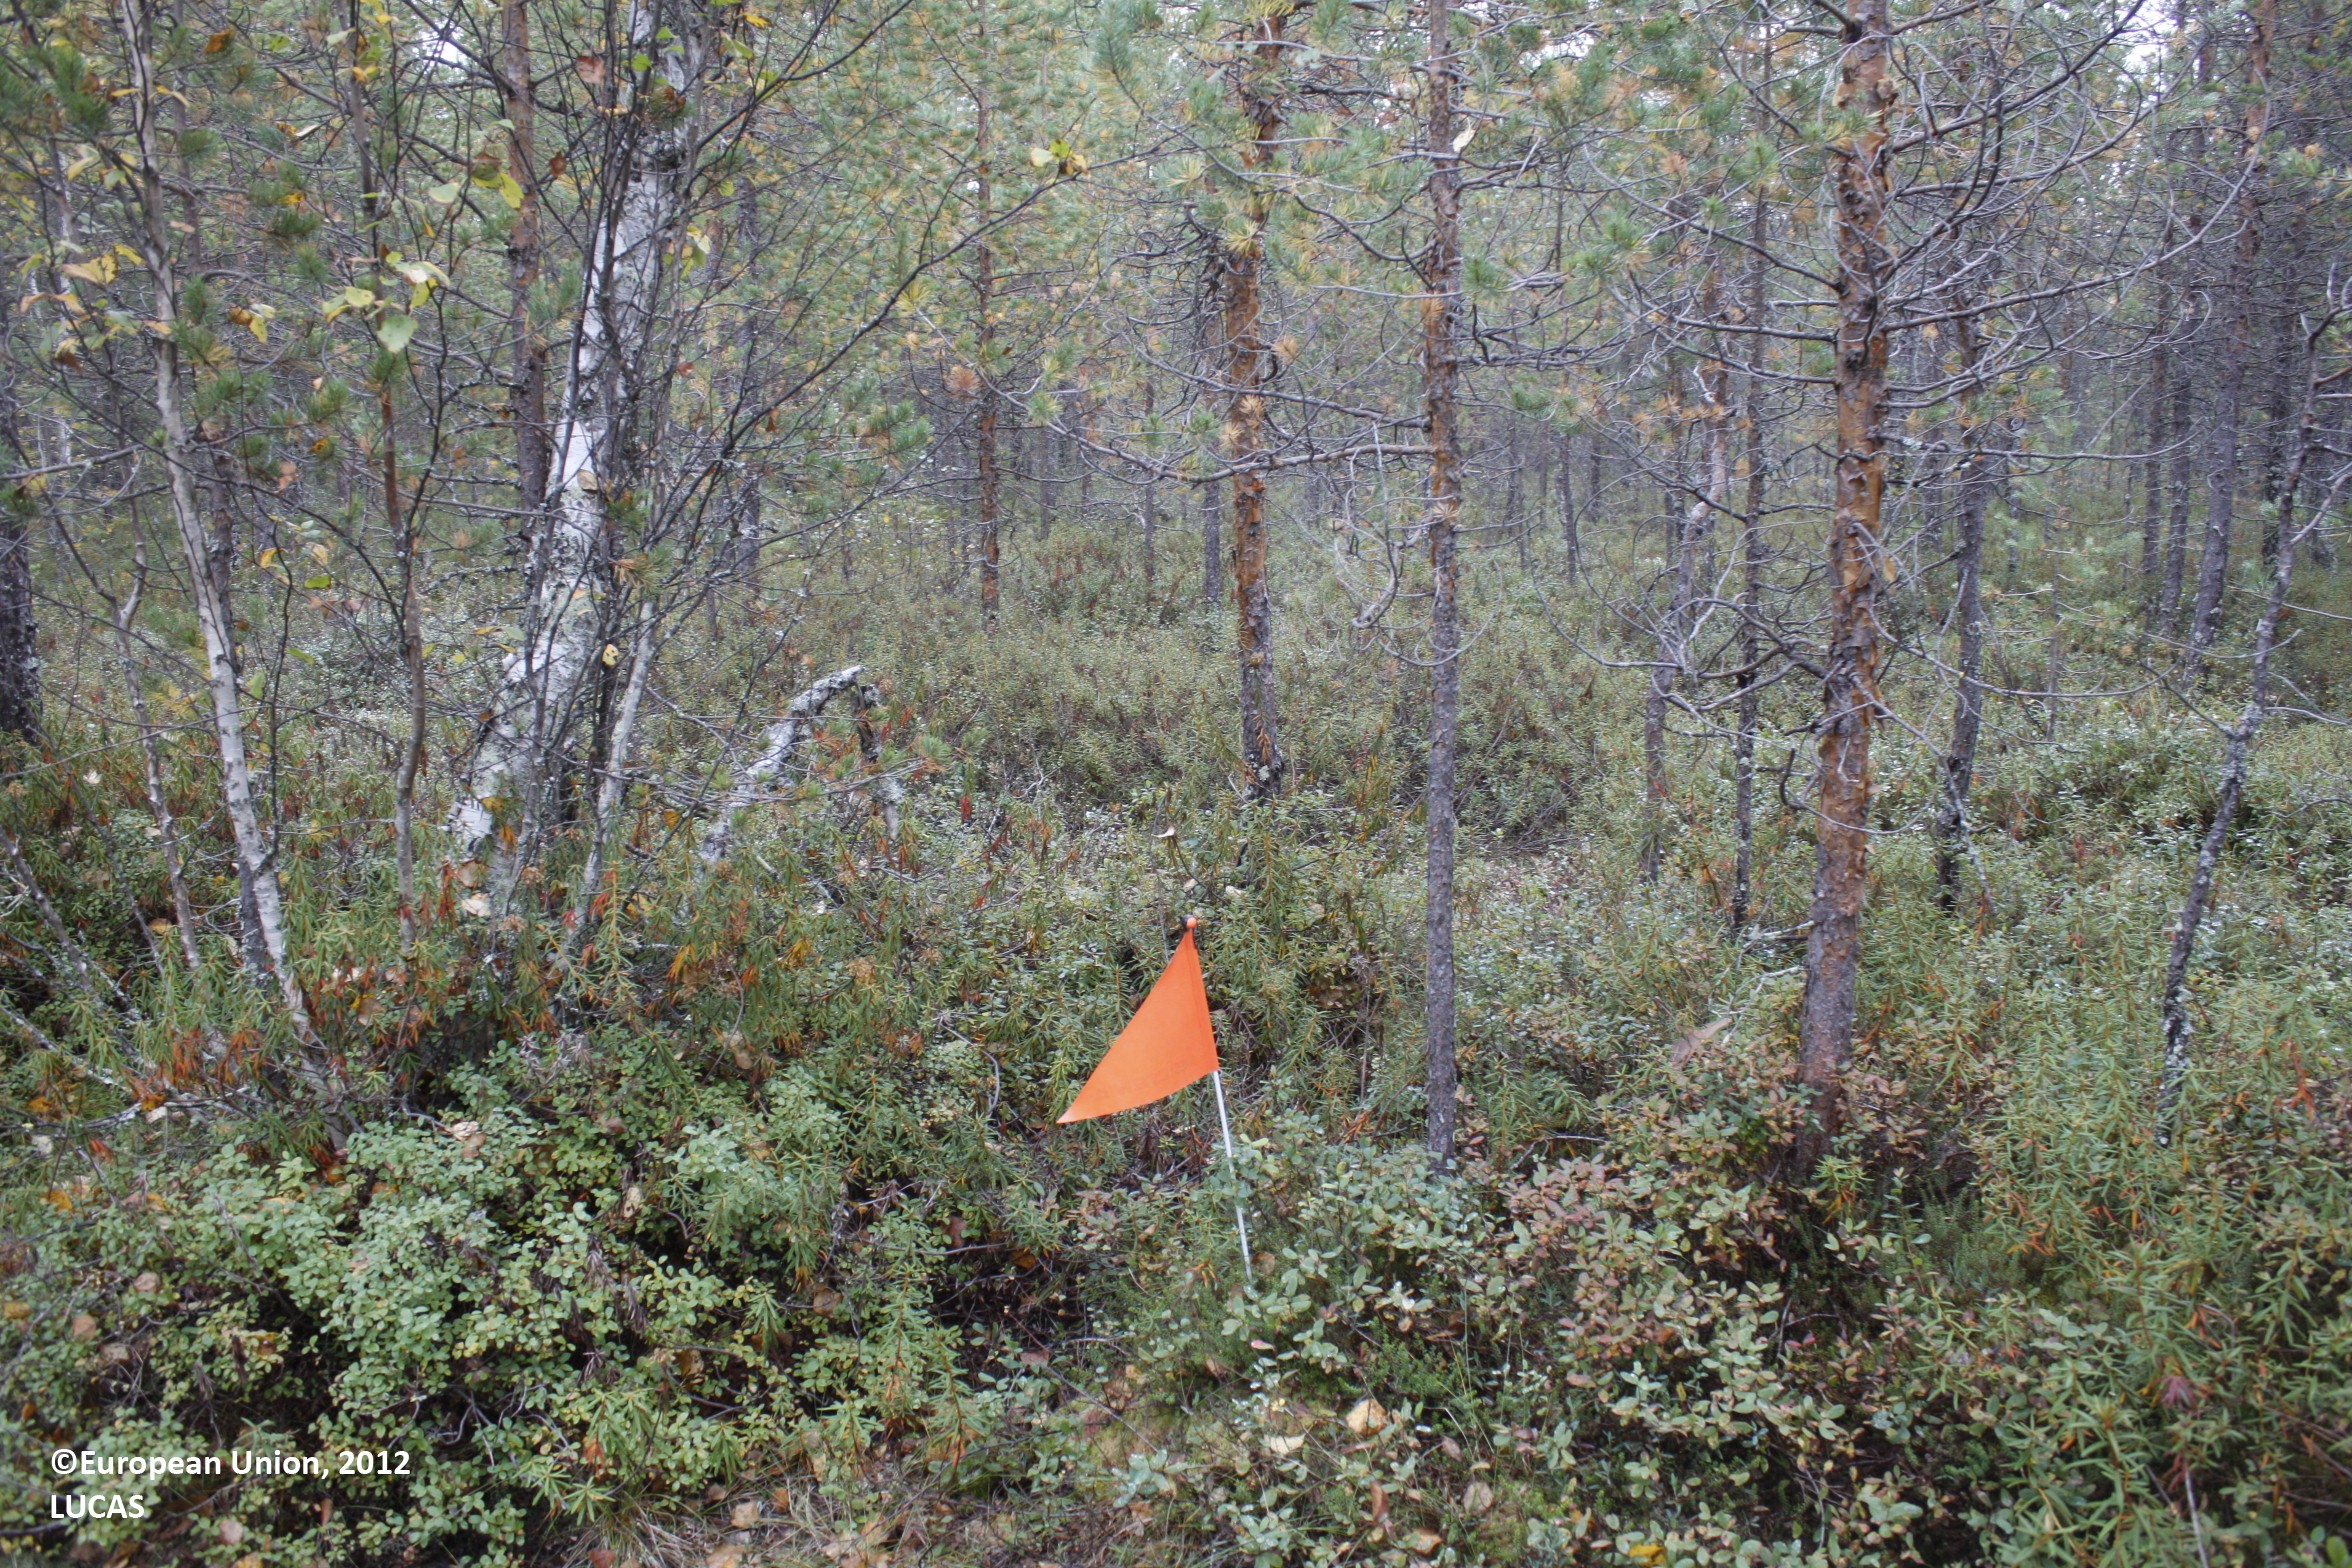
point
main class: Woodland
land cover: Pine dominated coniferous woodland
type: boreal forest
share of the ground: 50 - 75 %
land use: Forestry
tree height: > 5 m
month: September
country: FI
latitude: 65.1487
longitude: 26.7682
